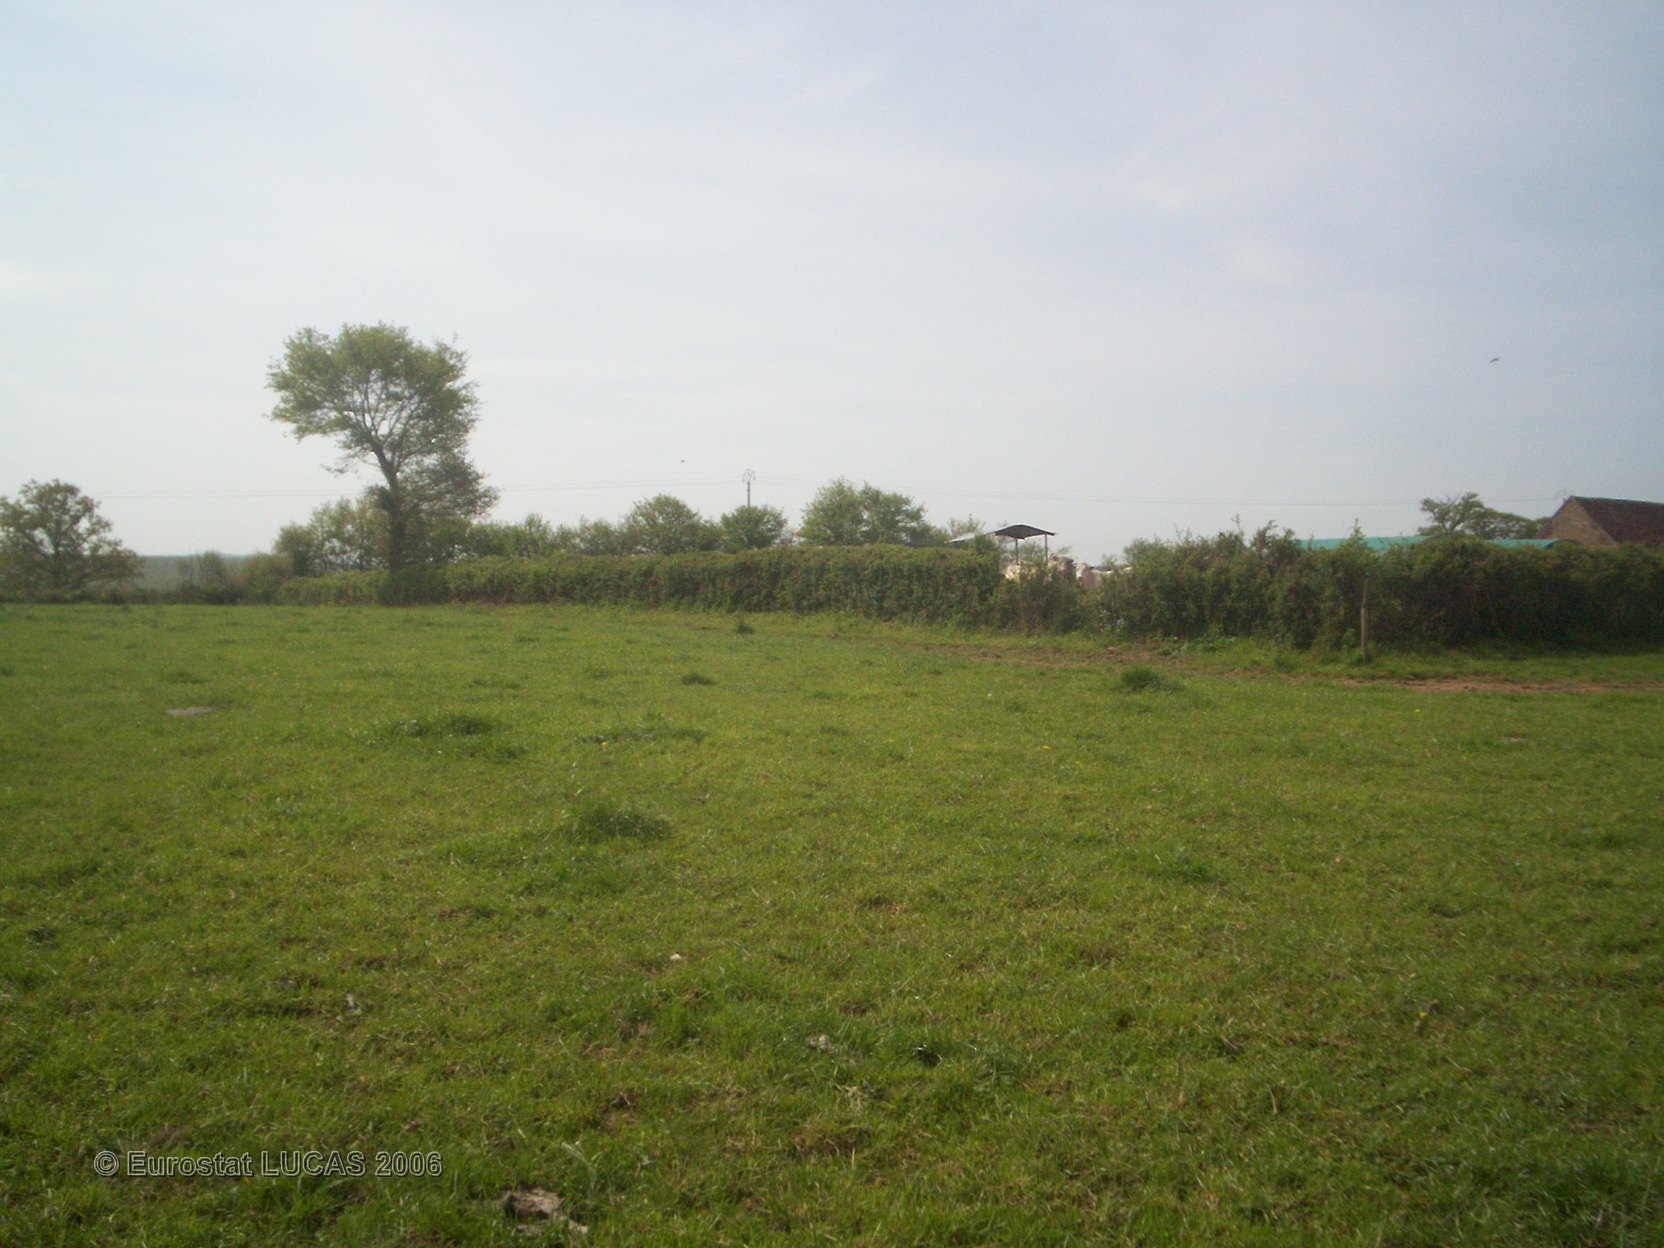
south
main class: Grassland
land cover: Grassland without tree/shrub cover
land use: Agriculture (excluding fallow land and kitchen gardens)
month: May
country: FR
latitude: 46.5601
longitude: 3.0705
